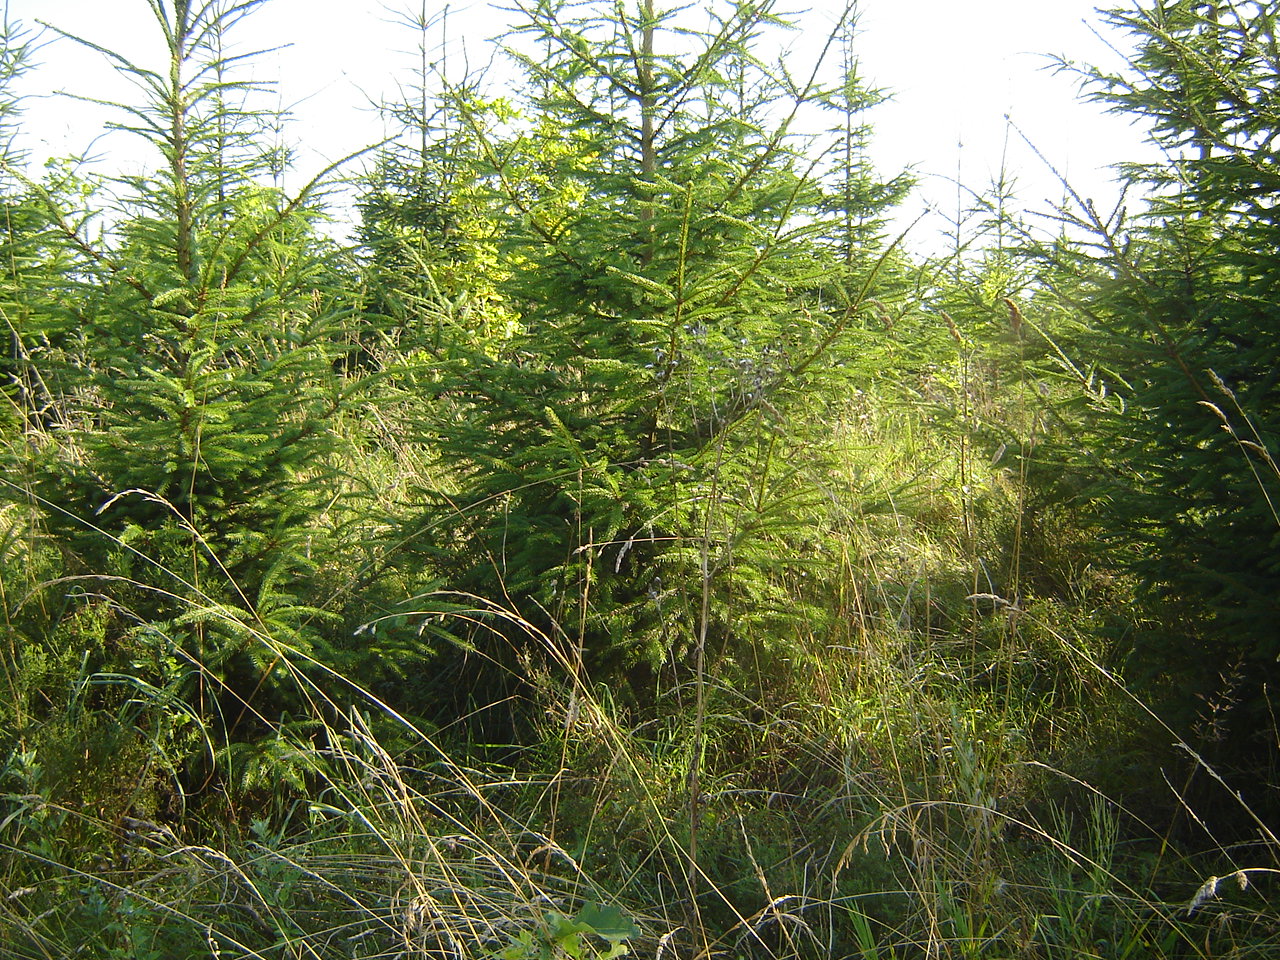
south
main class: Woodland
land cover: Spruce dominated coniferous woodland
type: hemiboreal forest and nemoral coniferous forest and mixed broadleaved-coniferous forest
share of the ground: > 75 %
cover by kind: coniferous forest trees 75 %, broadleaved forest trees 15 %, herbaceous plants 10 %
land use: Forestry
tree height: < 5 m
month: August
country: LT
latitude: 55.2014
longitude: 24.8952
